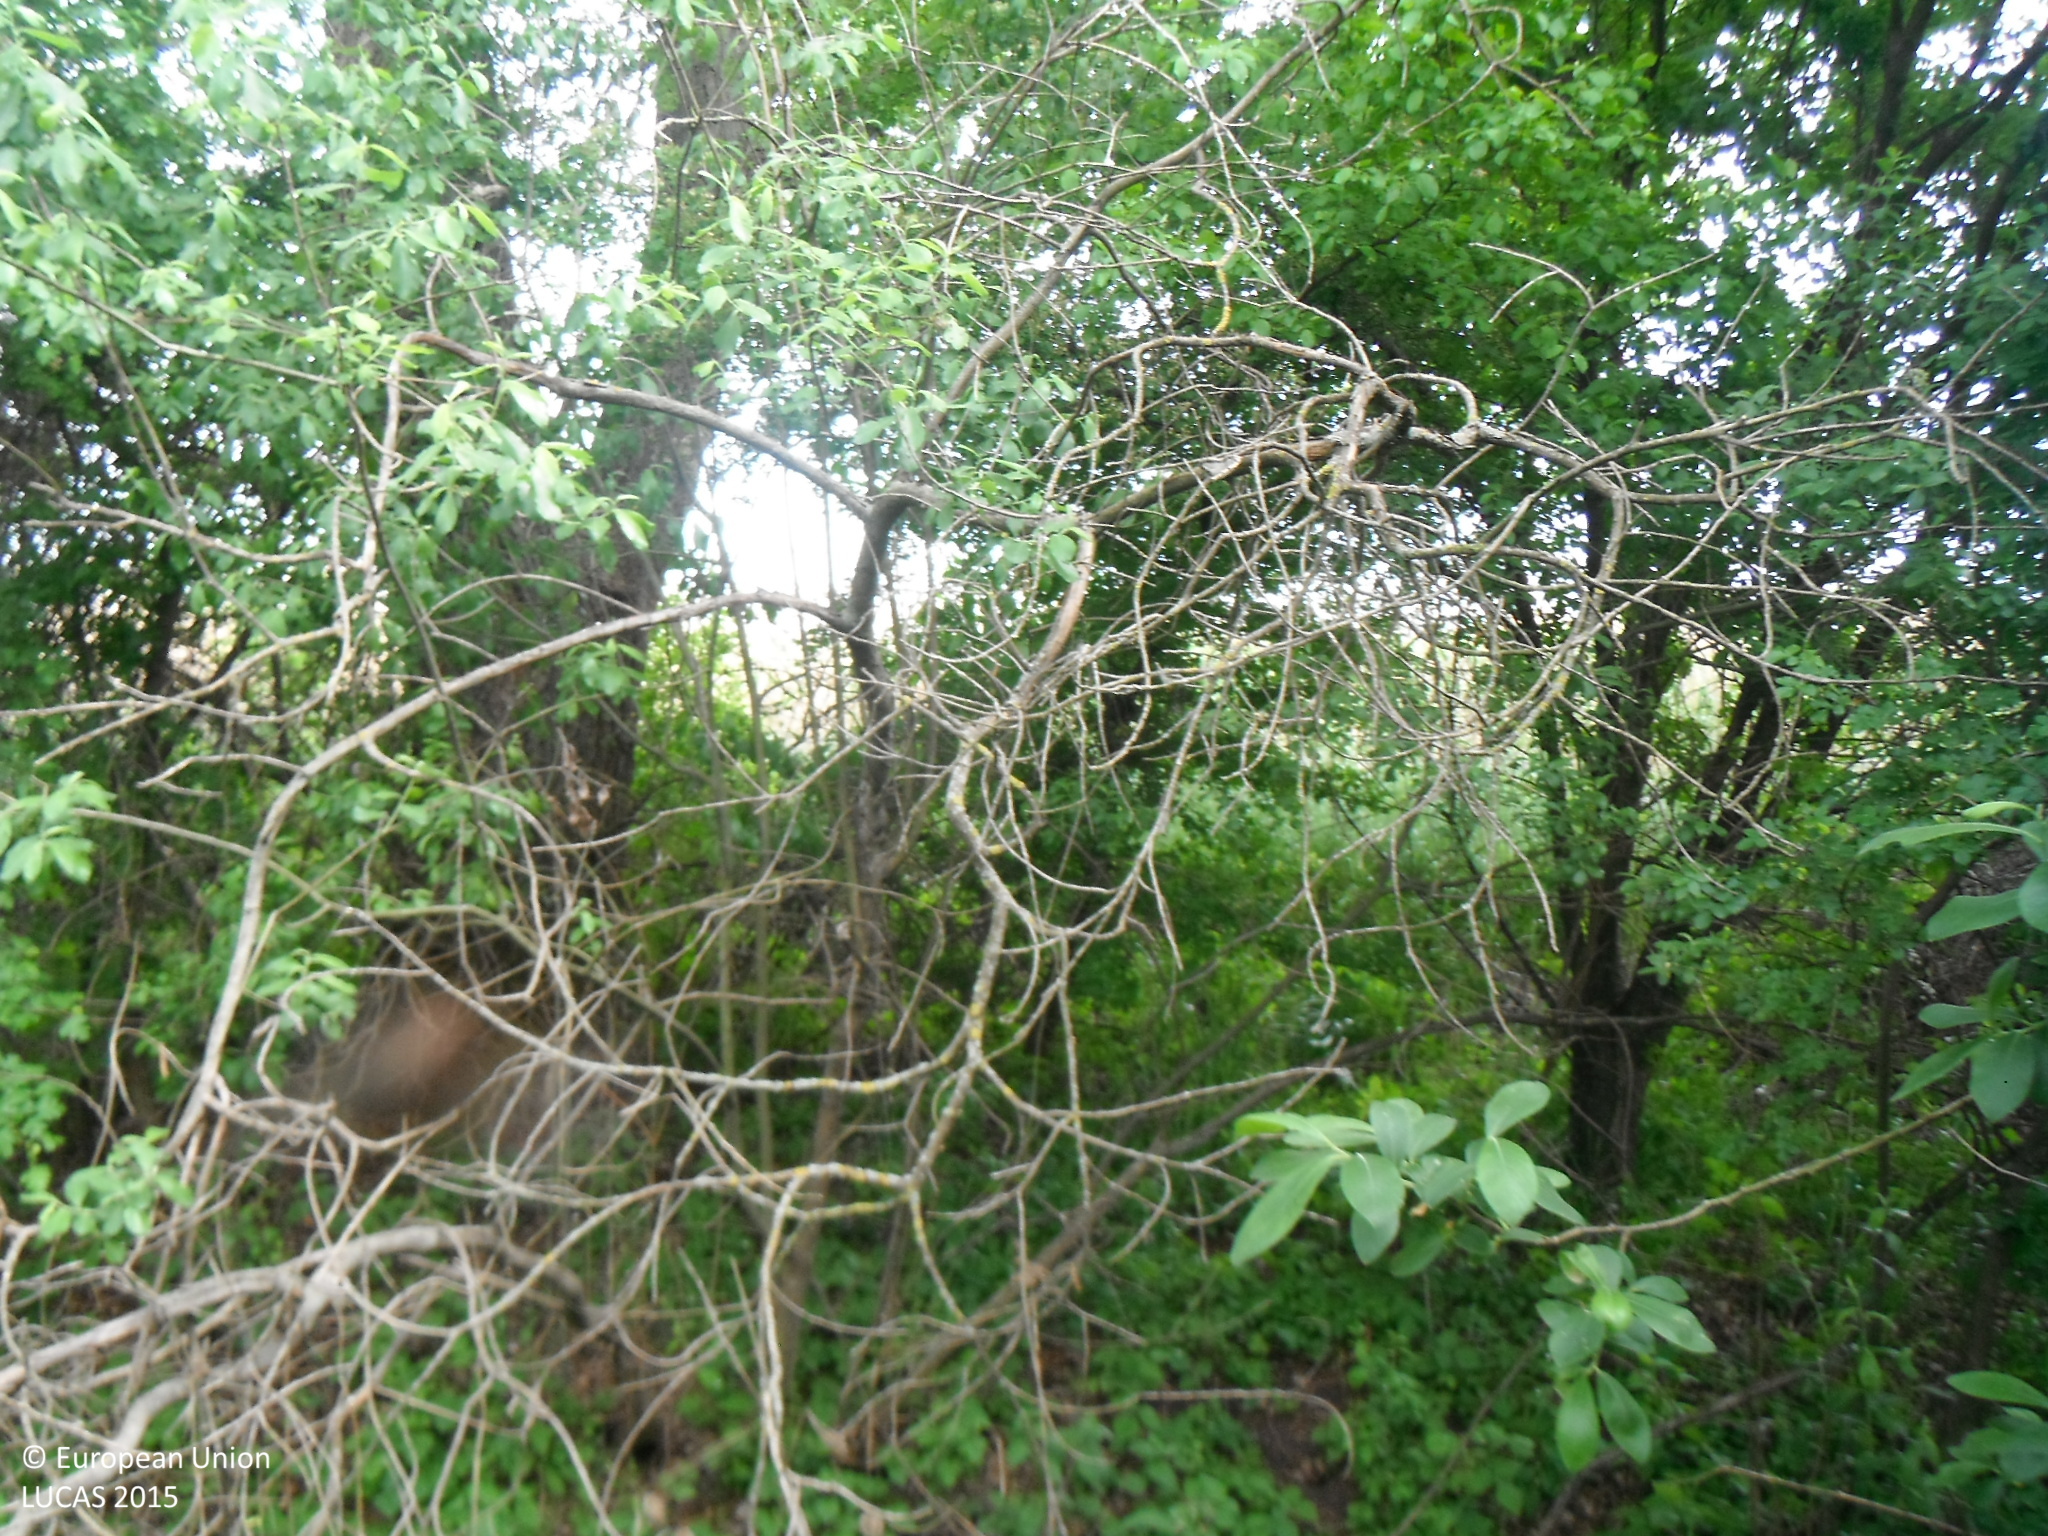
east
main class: Woodland
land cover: Broadleaved woodland
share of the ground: 25 - 50 %
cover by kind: shrubs 40 %, broadleaved forest trees 30 %, herbaceous plants 30 %
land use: Semi-natural and natural areas not in use
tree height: > 5 m
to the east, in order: Broadleaved woodland; Tracks; Grass margins; Inland marshes; Inland fresh water bodies
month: May
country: SK
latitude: 48.0520
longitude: 17.5902
